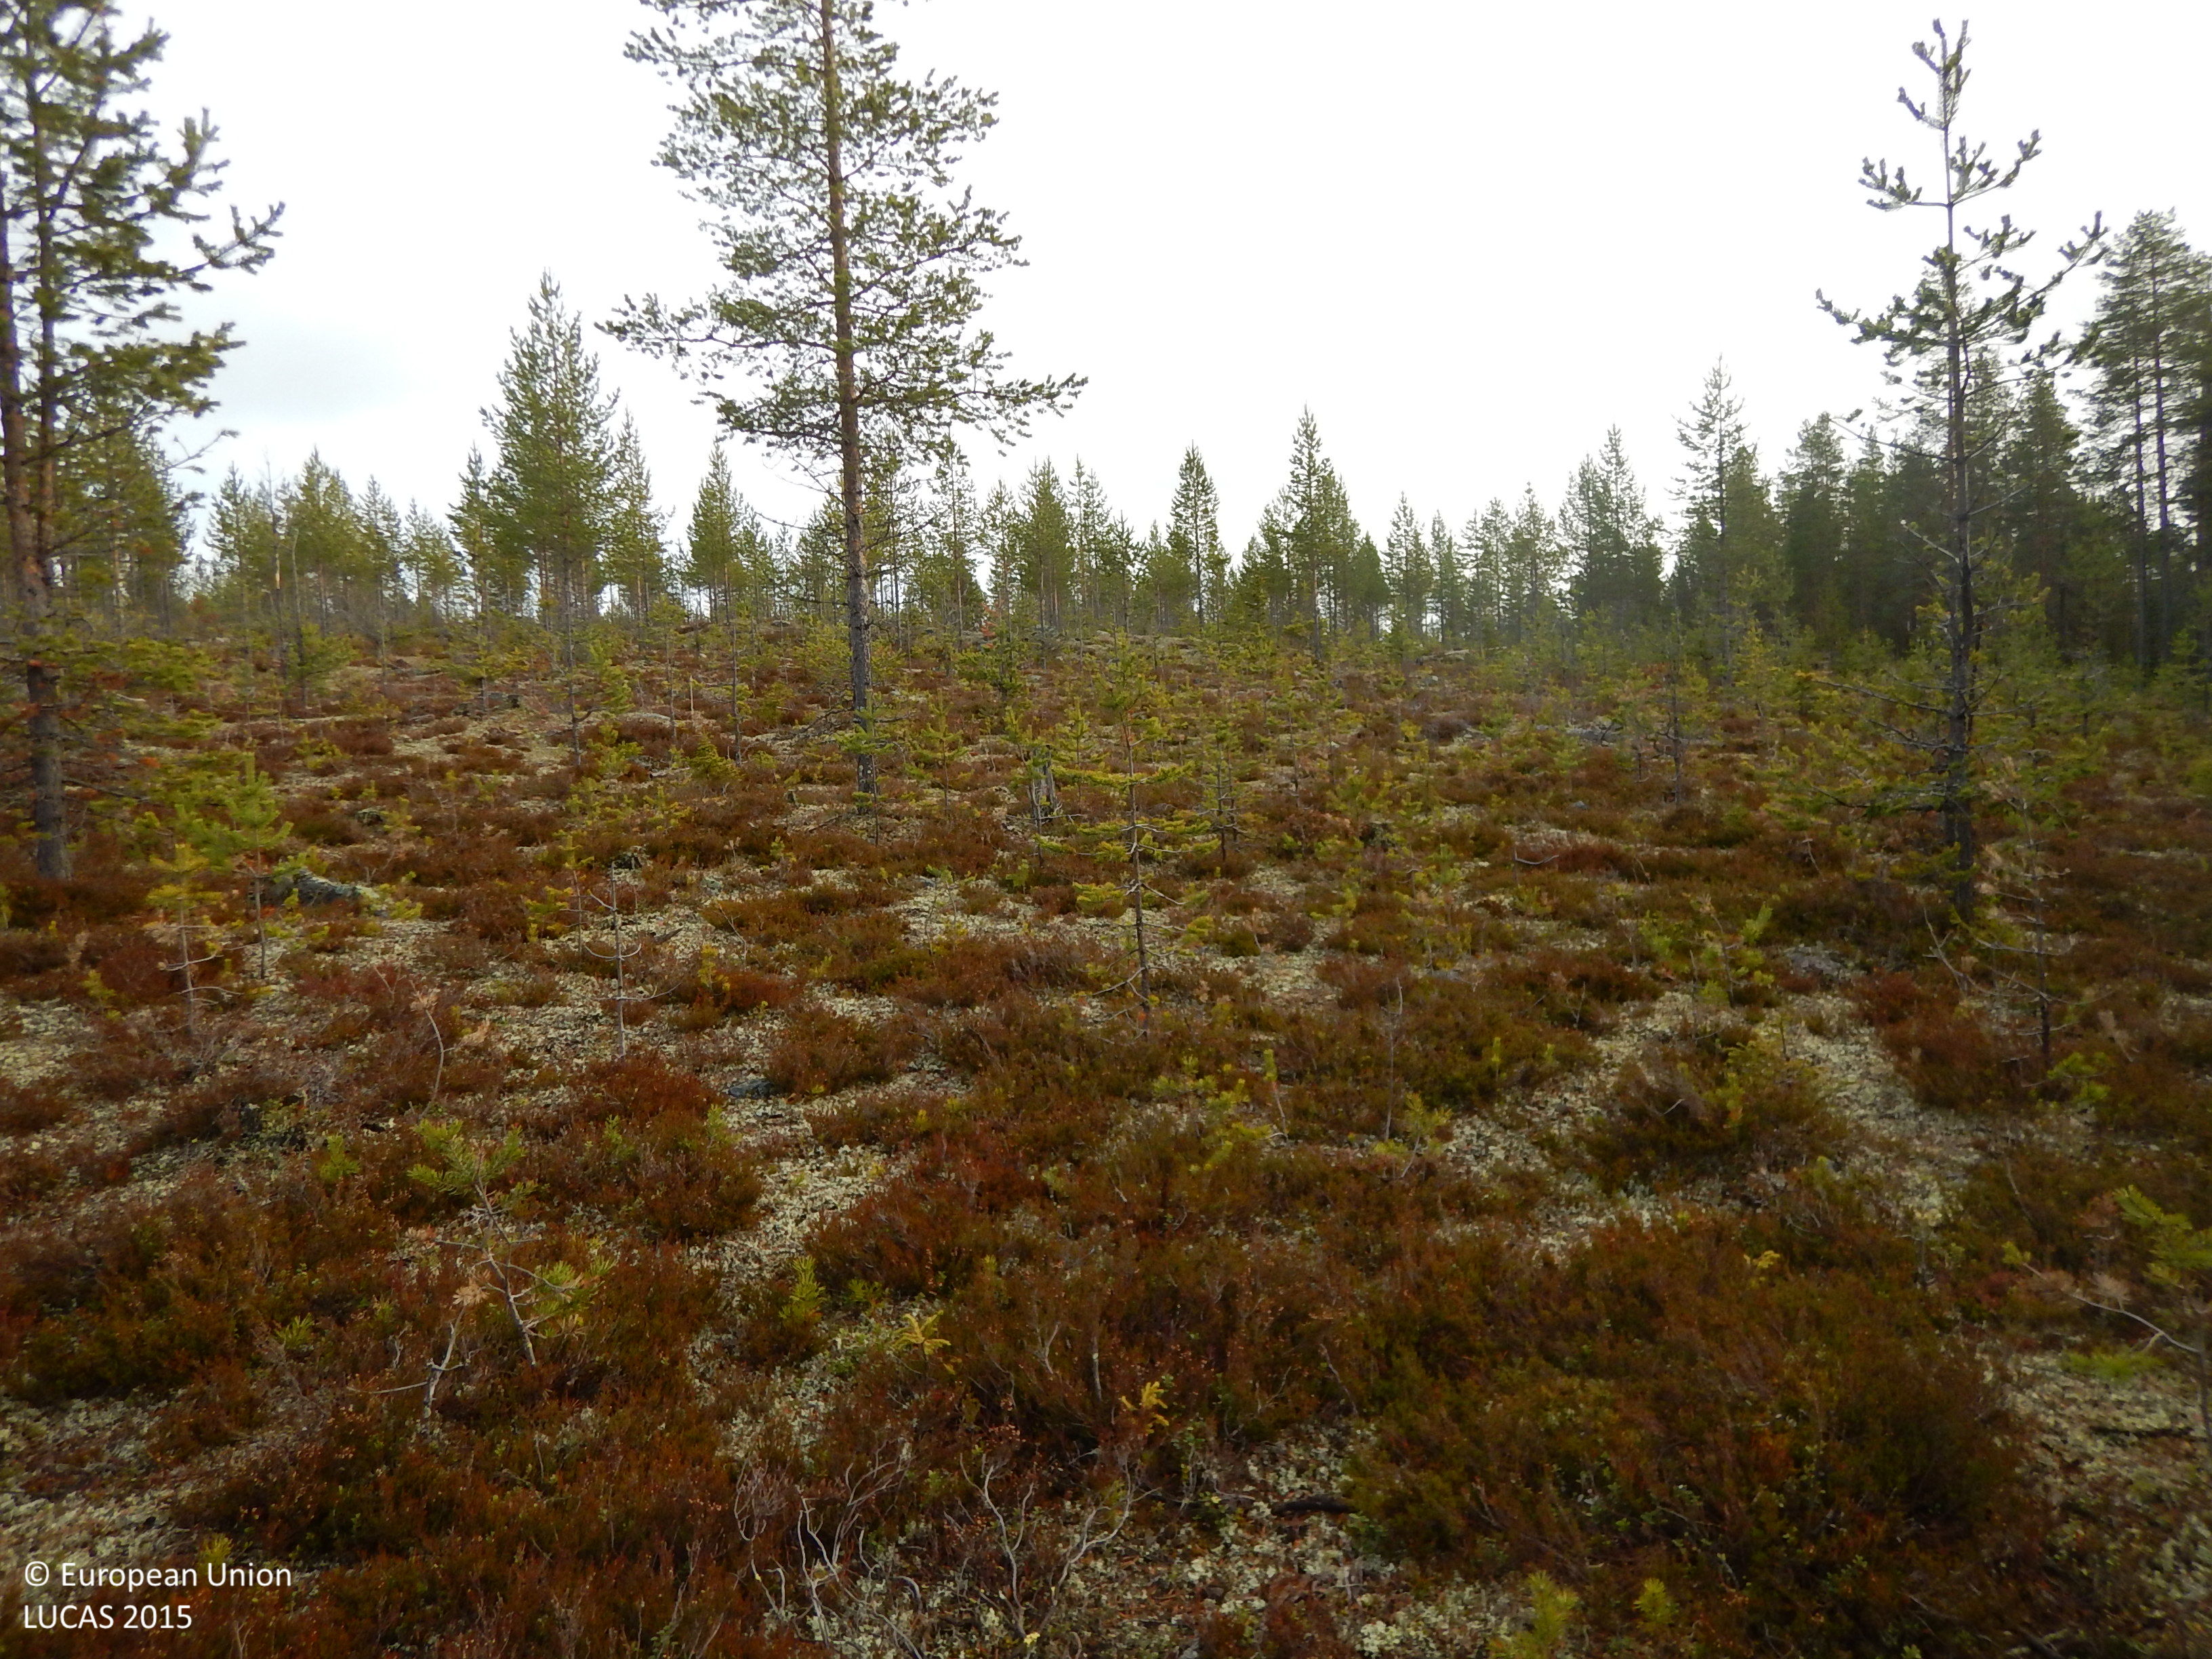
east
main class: Woodland
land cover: Pine dominated coniferous woodland
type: boreal forest
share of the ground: 10 - 25 %
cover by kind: shrubs 50 %, coniferous forest trees 25 %, lichens and mosses 20 %, herbaceous plants 5 %
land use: Forestry
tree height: < 5 m
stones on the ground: < 10 %
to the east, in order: Pine dominated coniferous woodland
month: October
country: SE
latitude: 65.2818
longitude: 20.0617
